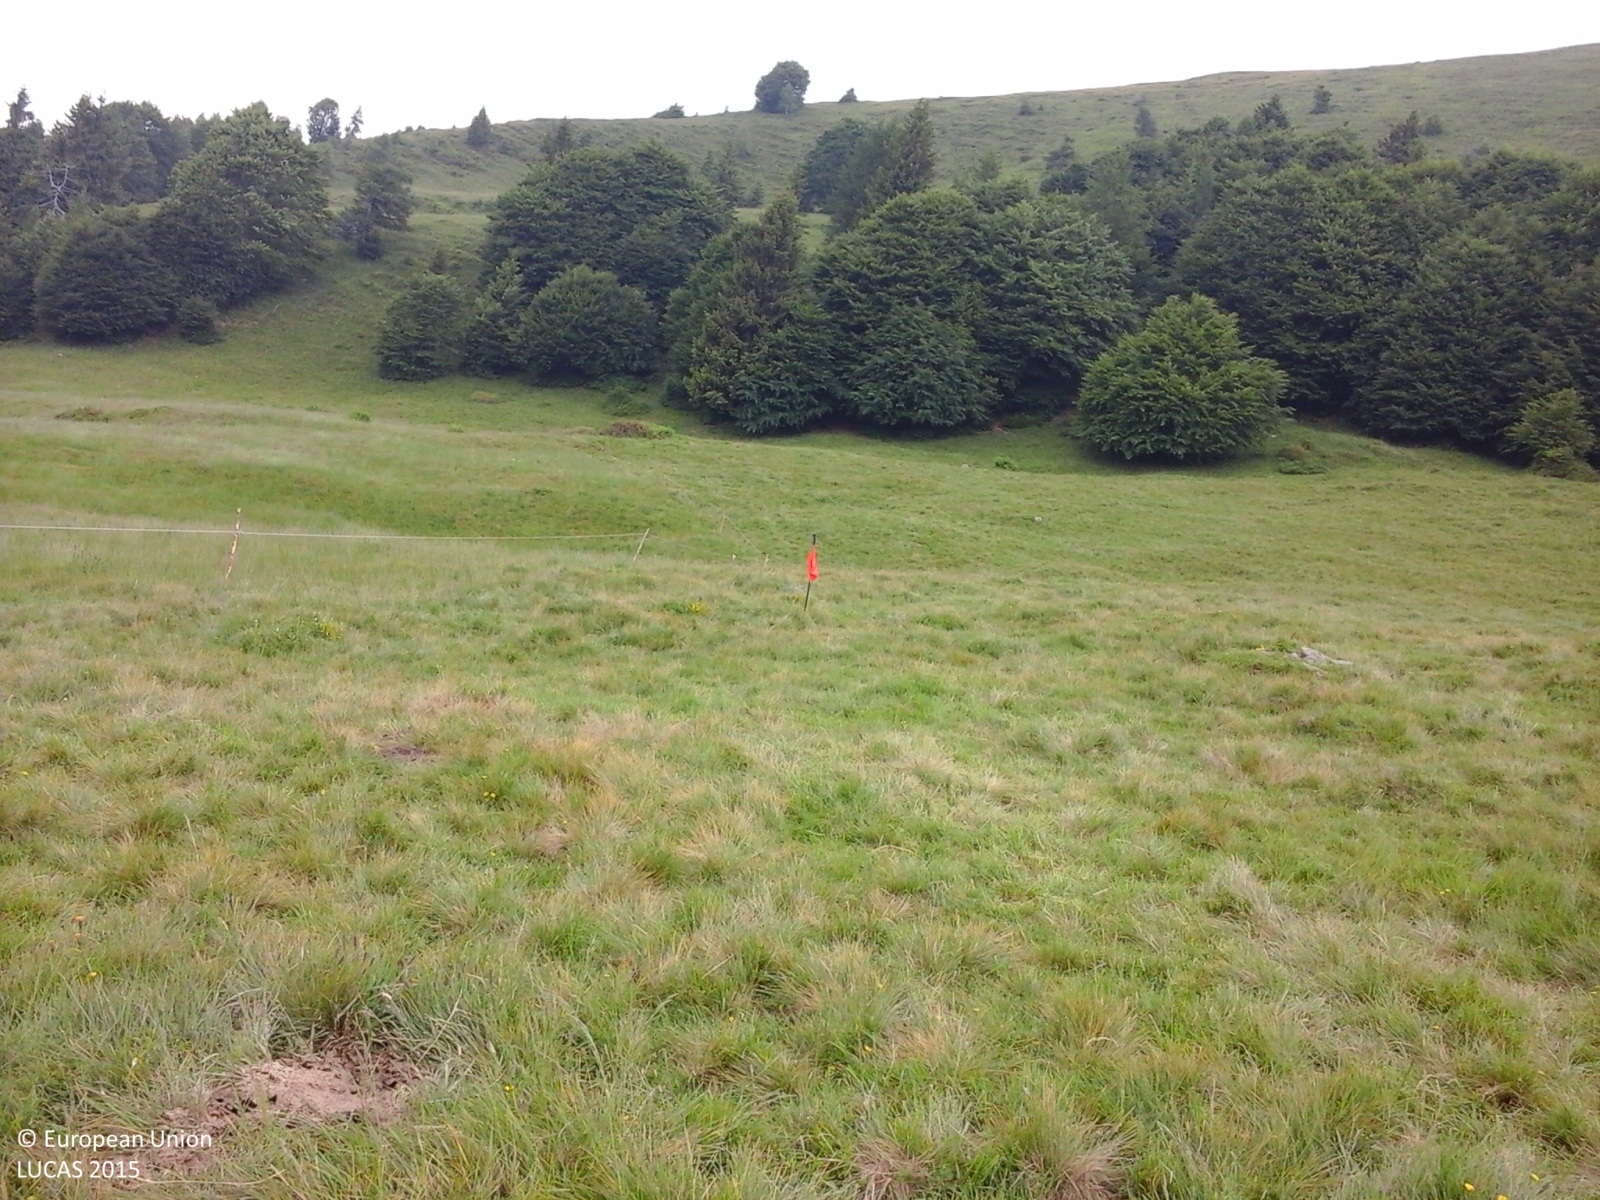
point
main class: Grassland
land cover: Grassland without tree/shrub cover
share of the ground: > 75 %
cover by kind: herbaceous plants 100 %
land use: Agriculture (excluding fallow land and kitchen gardens)
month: June
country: IT
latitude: 45.7925
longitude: 10.1927
